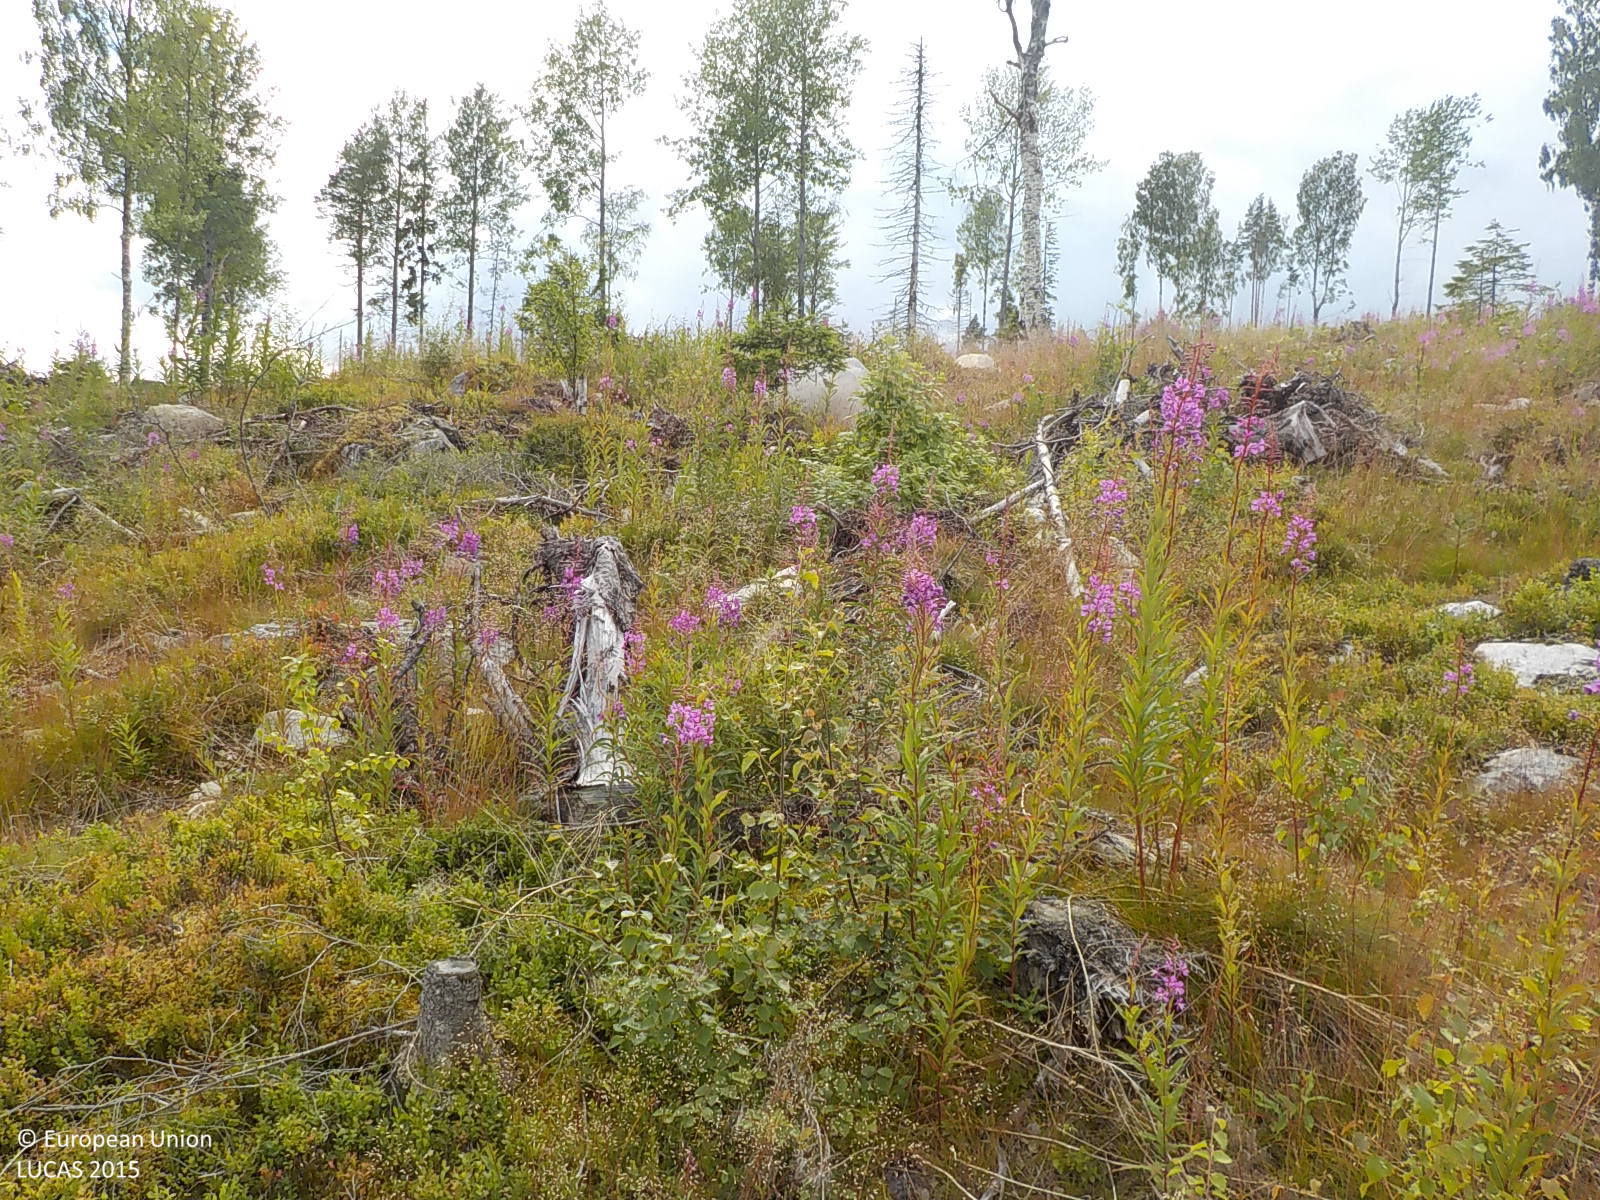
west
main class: Woodland
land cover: Broadleaved woodland
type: boreal forest
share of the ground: 50 - 75 %
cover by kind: broadleaved forest trees 50 %, herbaceous plants 45 %, shrubs 5 %
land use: Forestry
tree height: < 5 m
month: July
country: SE
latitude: 63.2657
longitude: 17.3675
